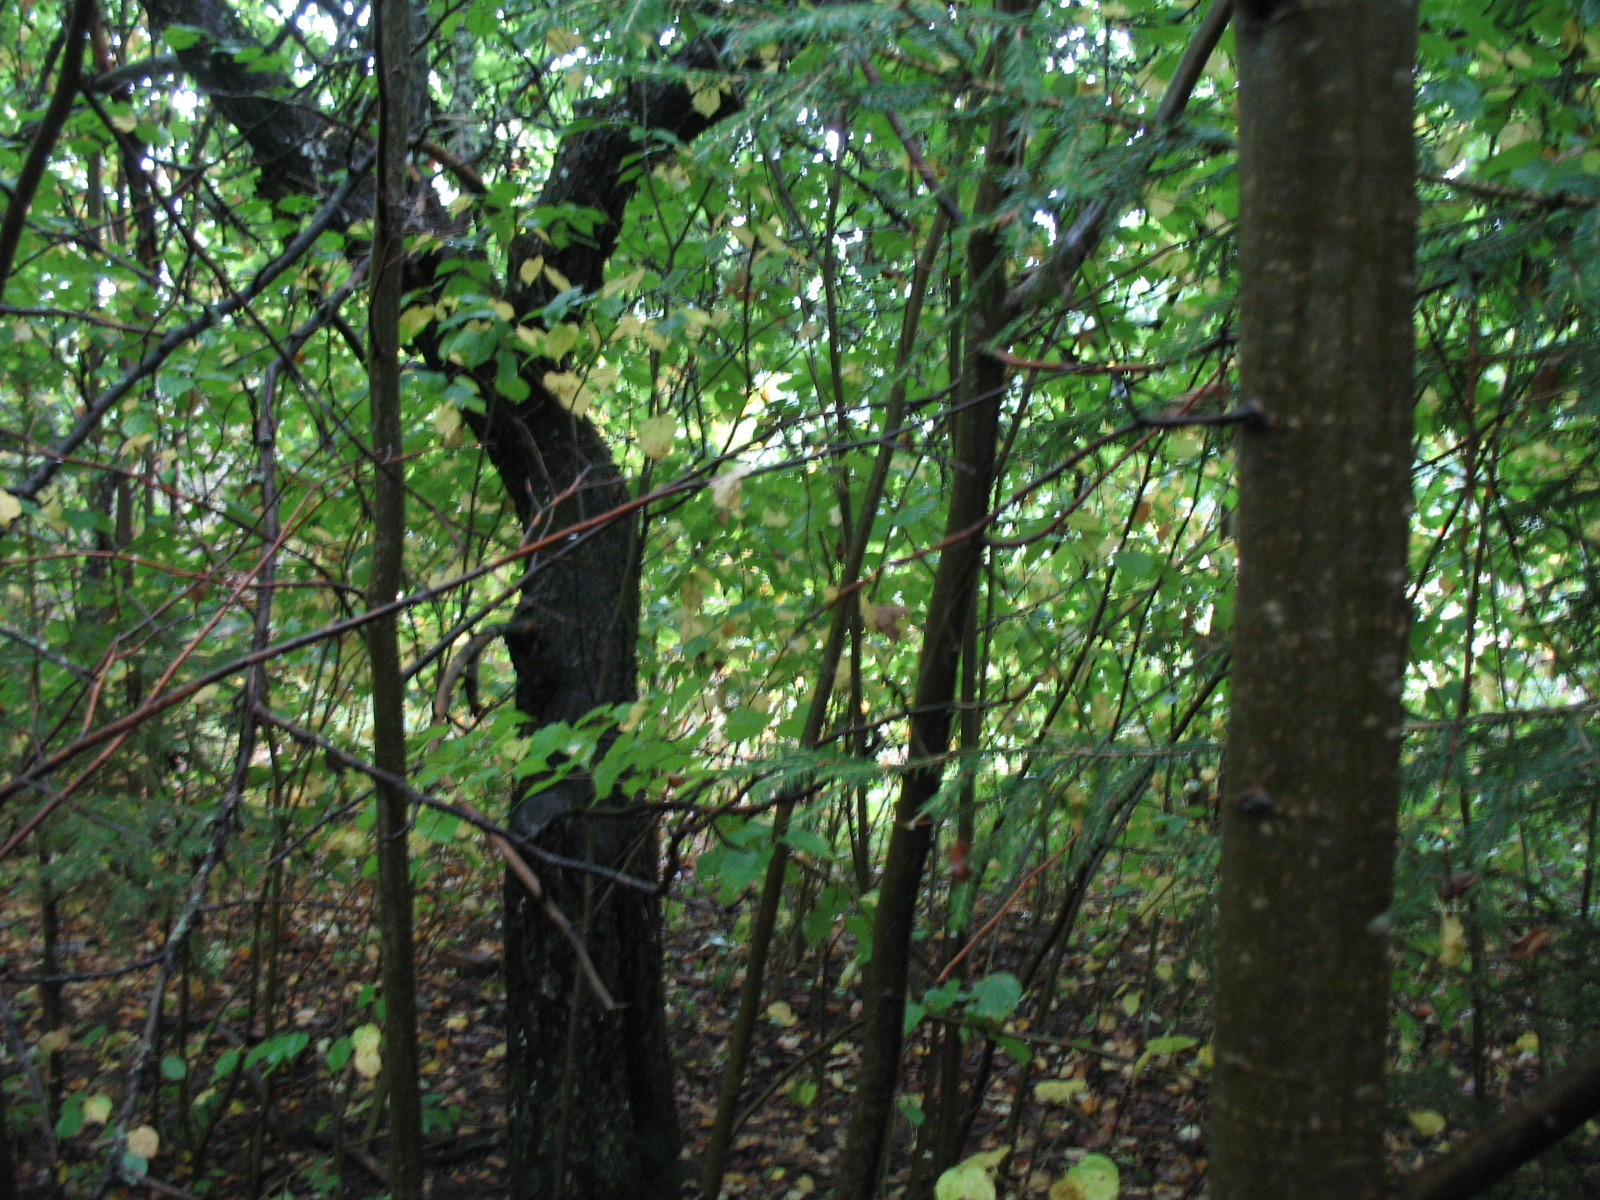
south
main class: Woodland
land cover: Broadleaved woodland
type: non-riverine alder, birch or aspen forest
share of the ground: > 75 %
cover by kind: broadleaved forest trees 80 %, coniferous forest trees 10 %, herbaceous plants 10 %
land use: Forestry
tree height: > 5 m
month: September
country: LV
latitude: 56.1252
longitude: 26.1789
